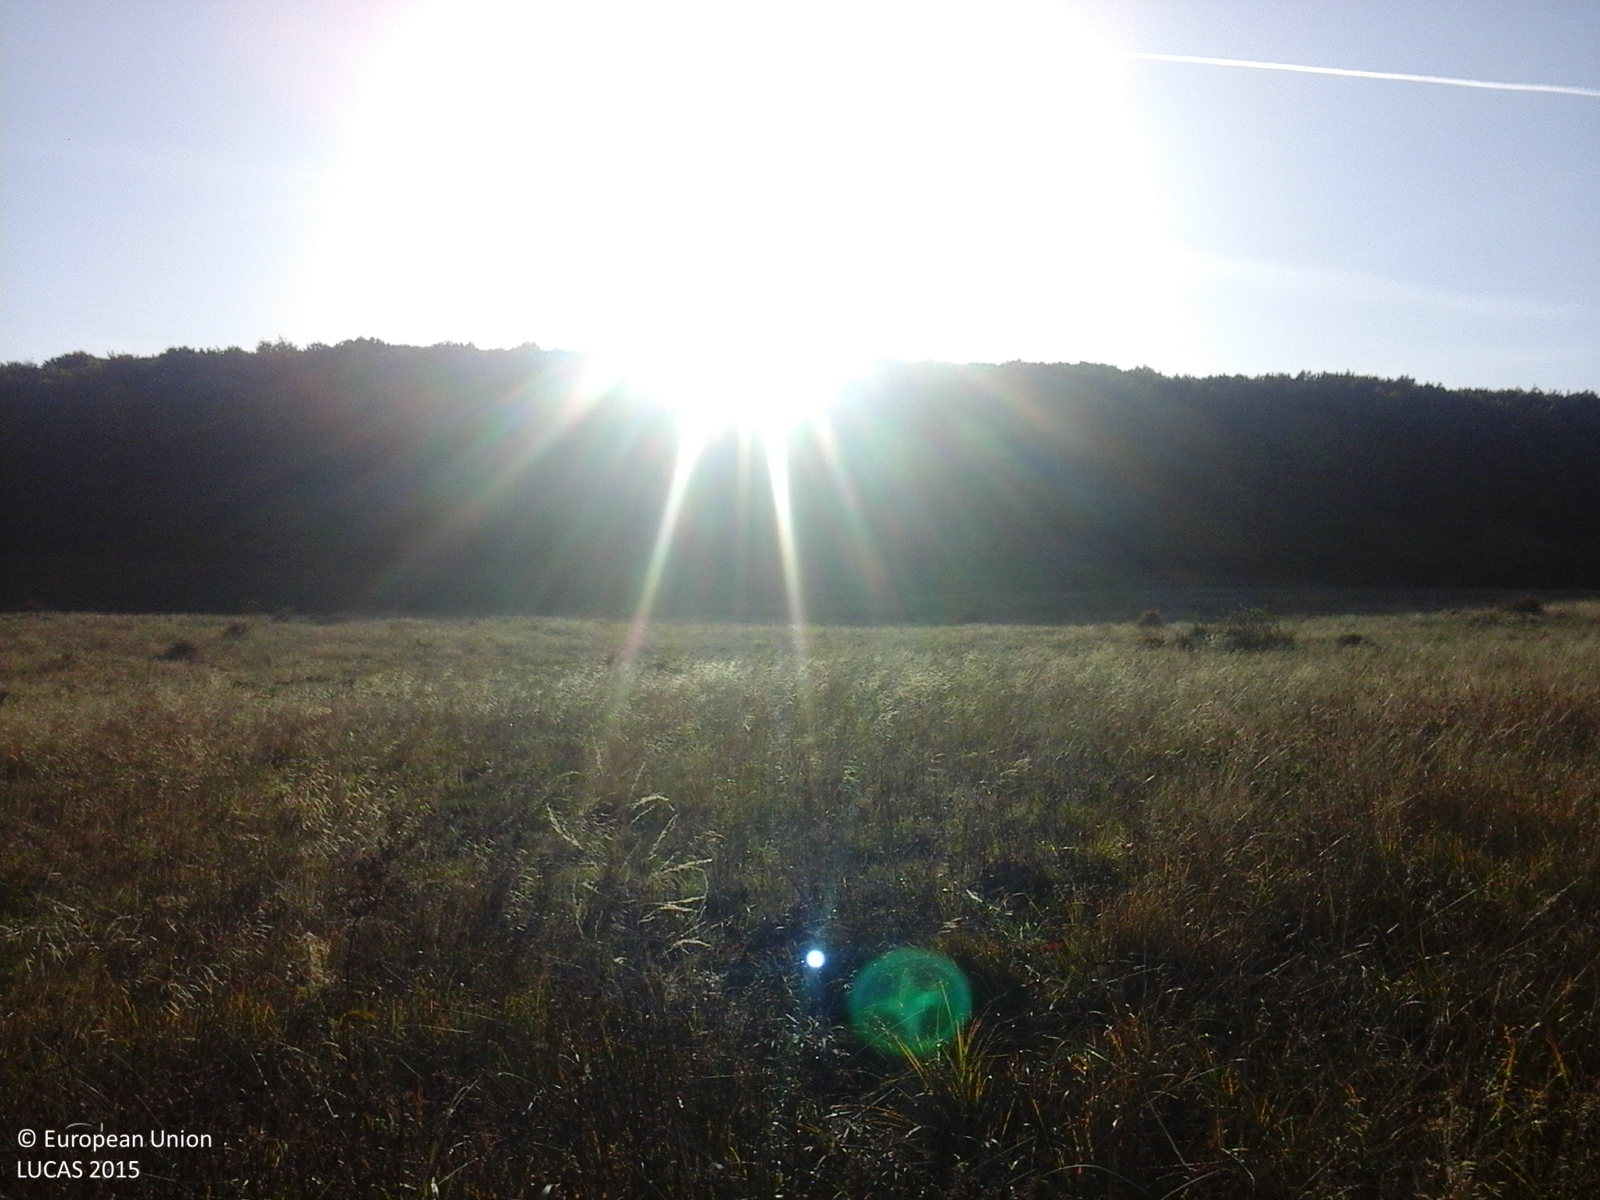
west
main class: Grassland
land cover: Grassland without tree/shrub cover
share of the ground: > 75 %
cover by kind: herbaceous plants 100 %
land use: Agriculture (excluding fallow land and kitchen gardens)
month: October
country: RO
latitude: 46.4526
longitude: 25.1637
